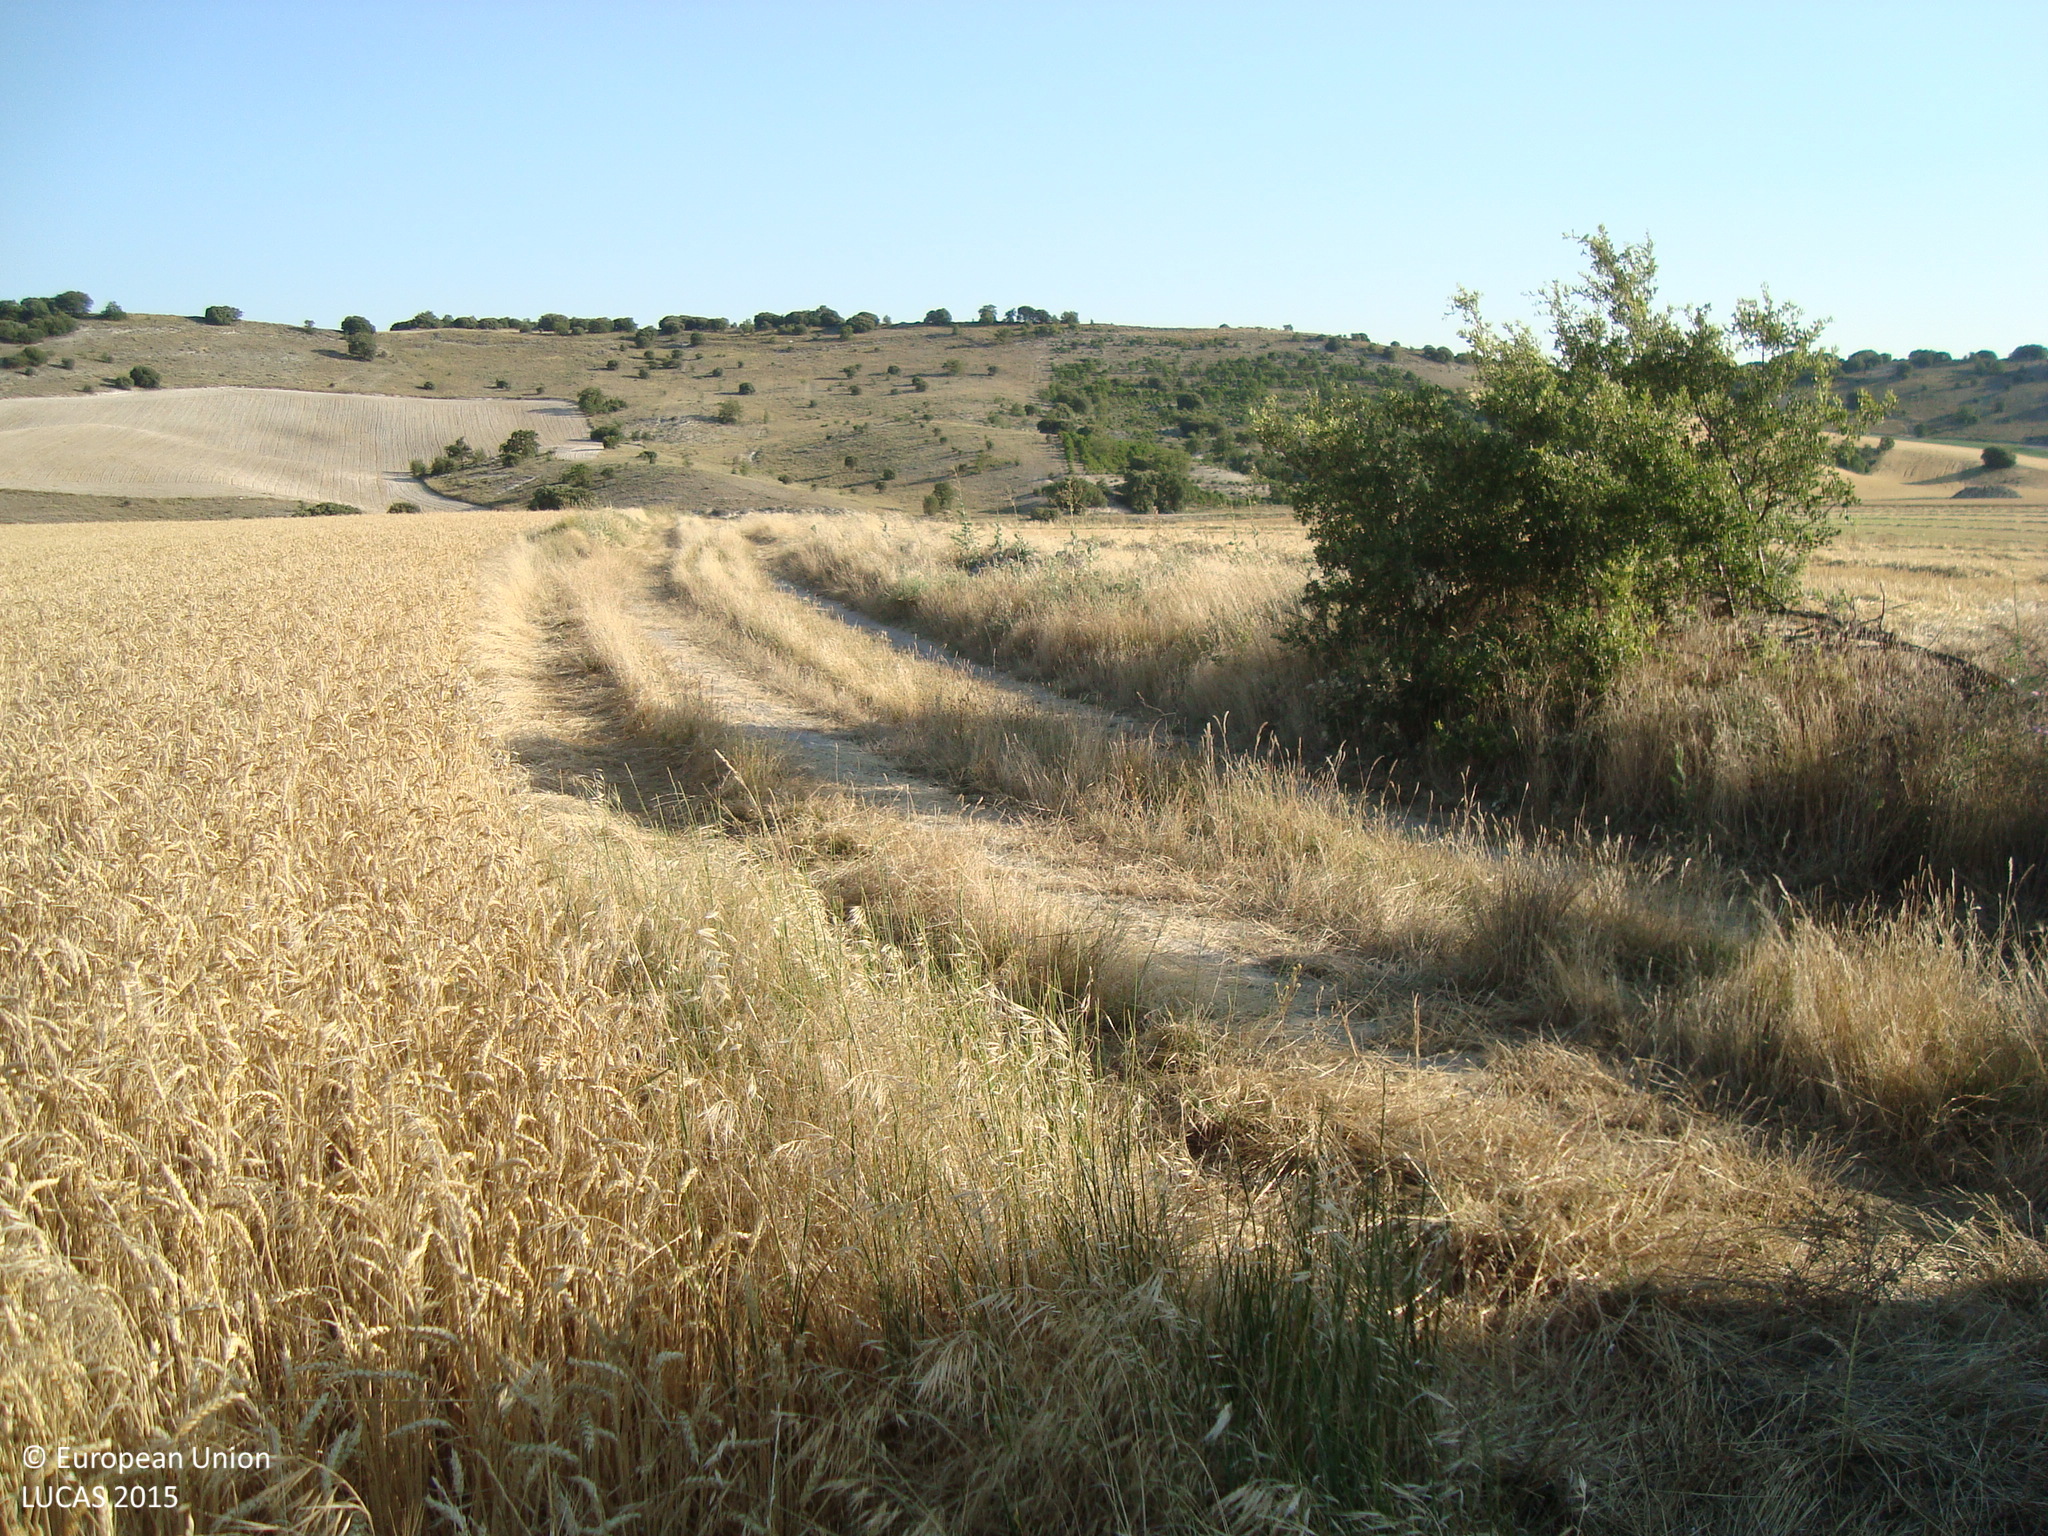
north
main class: Cropland
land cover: Common wheat
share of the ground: > 75 %
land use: Agriculture (excluding fallow land and kitchen gardens)
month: July
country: ES
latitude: 41.8580
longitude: -4.2662
